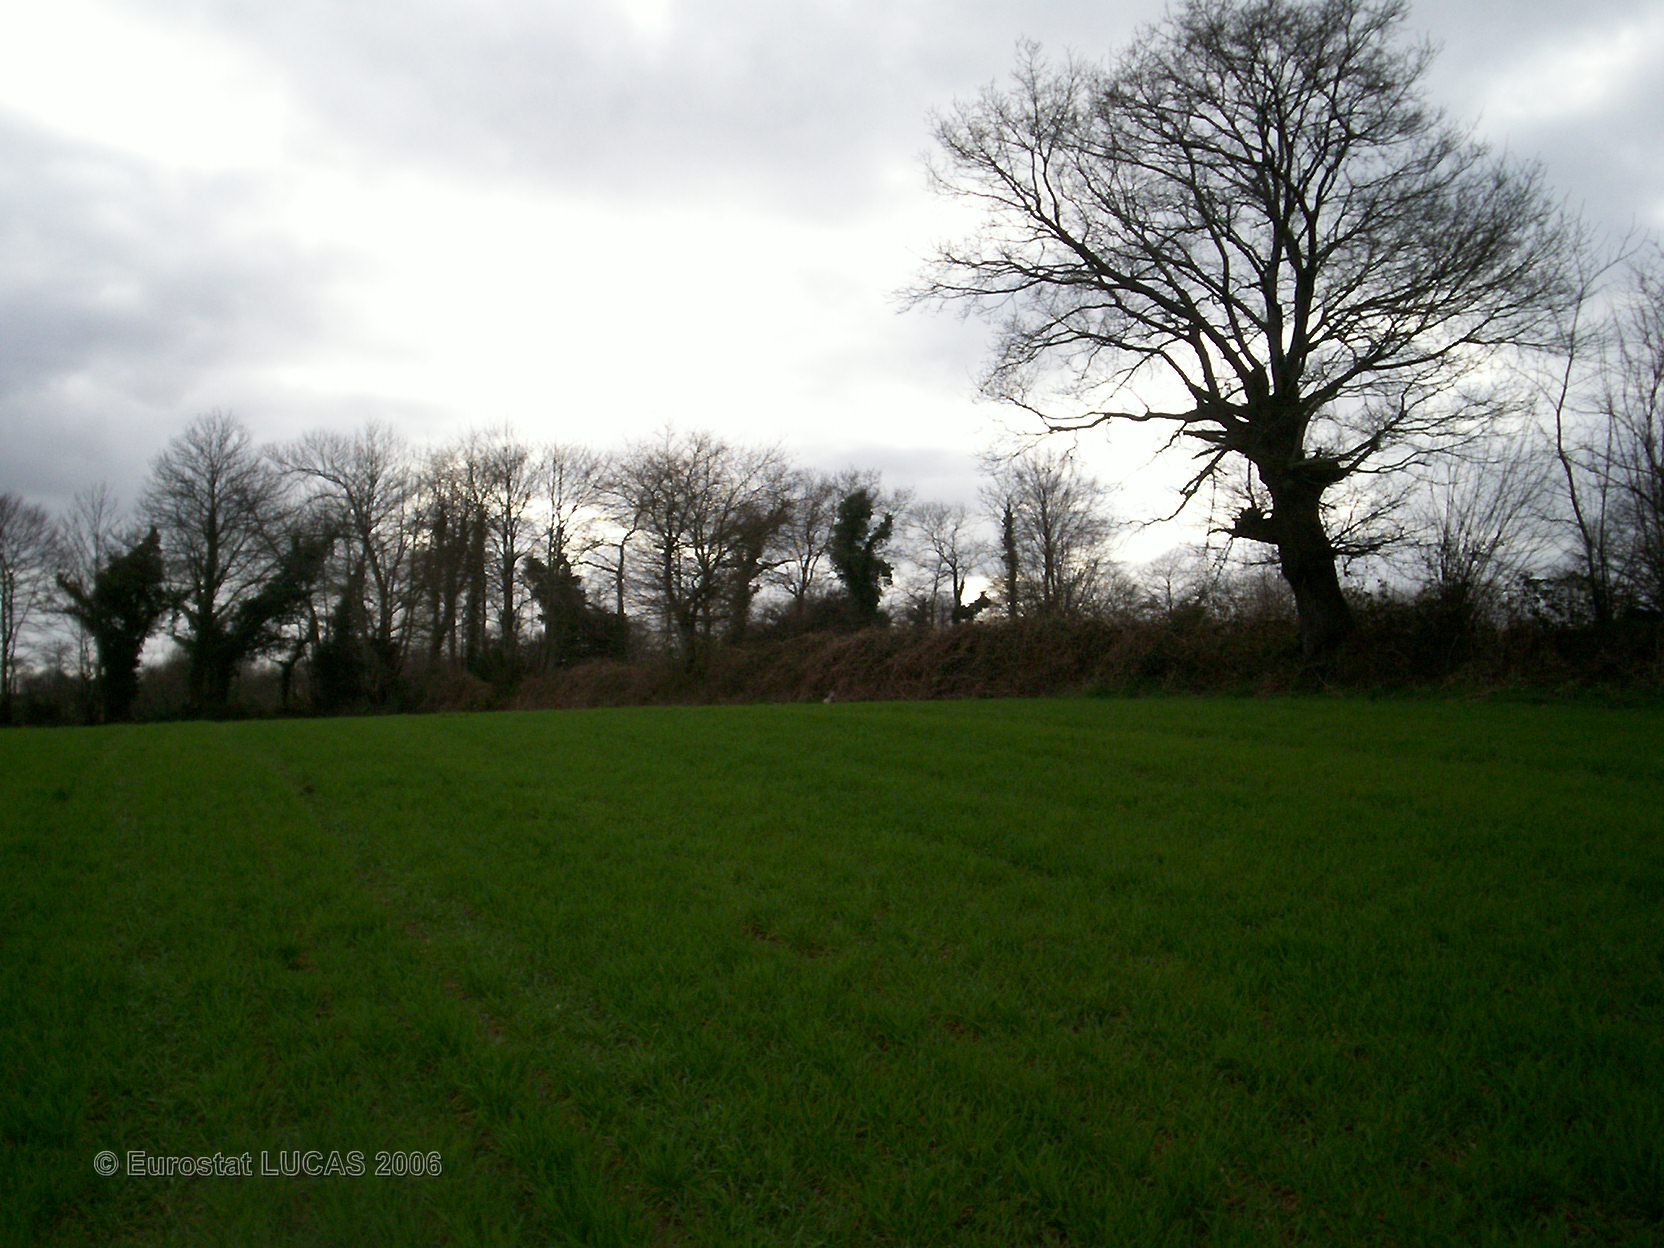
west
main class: Cropland
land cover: Barley
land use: Agriculture (excluding fallow land and kitchen gardens)
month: April
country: FR
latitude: 48.0491
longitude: -3.6150
